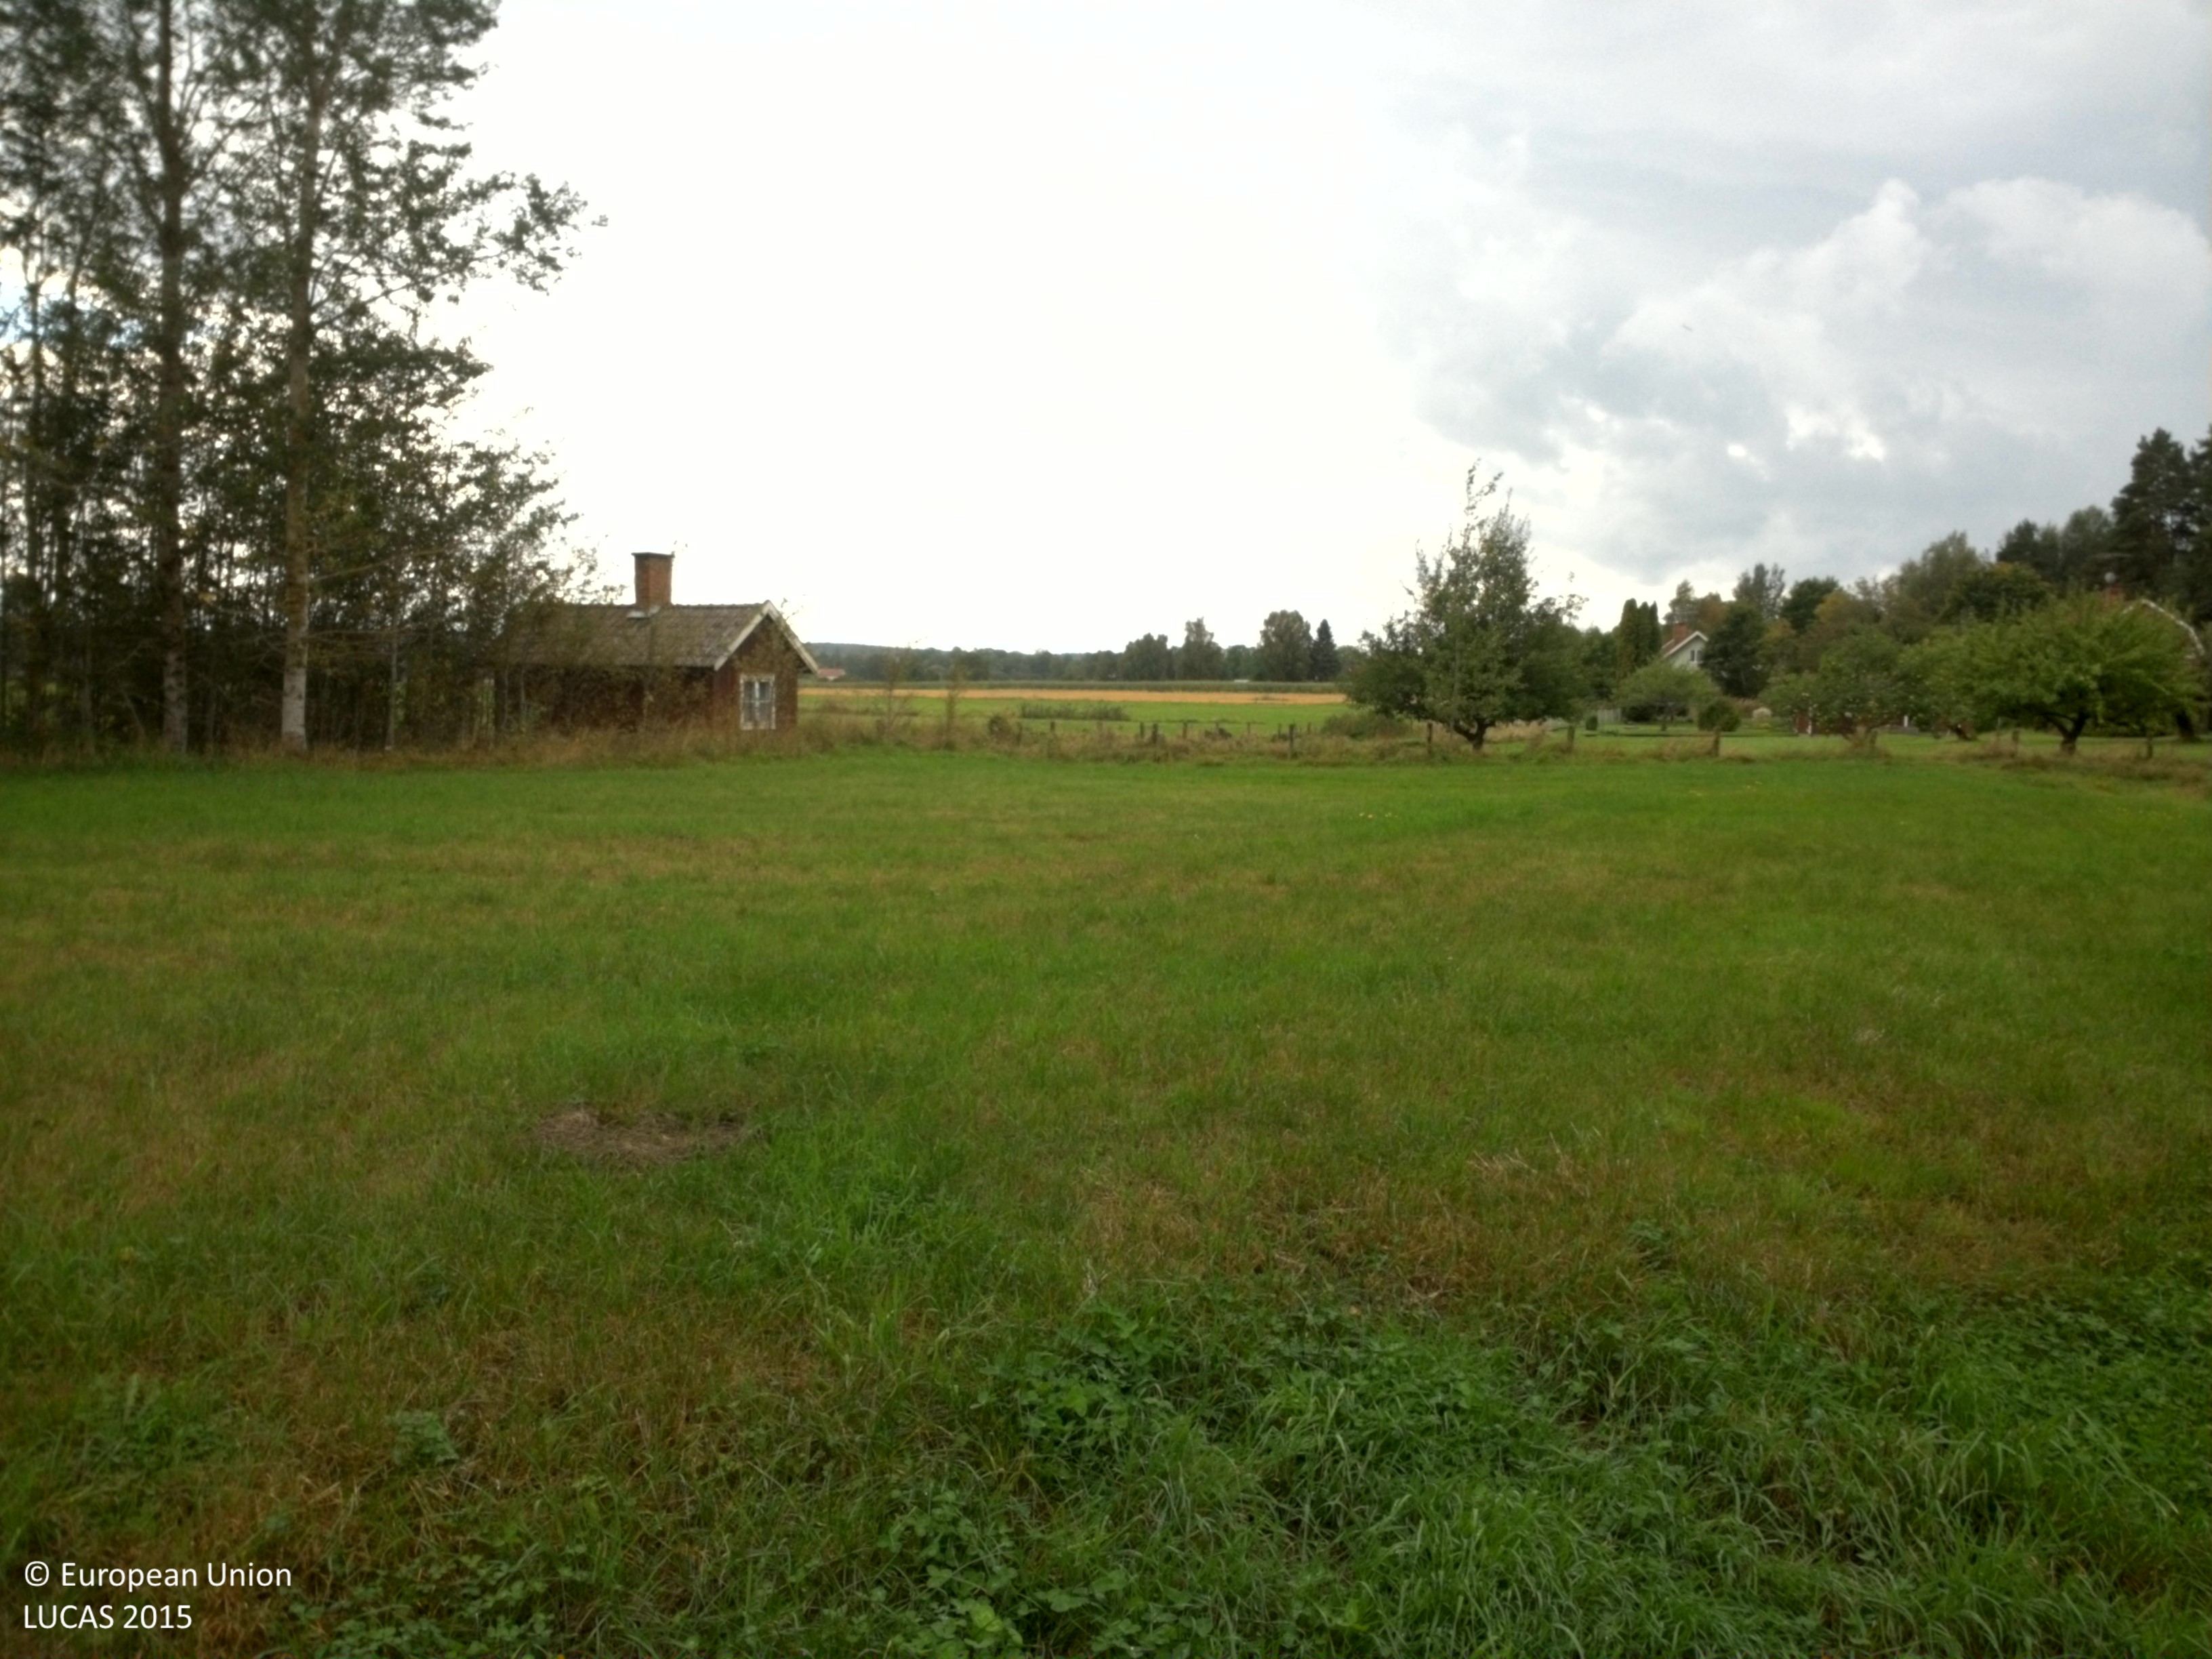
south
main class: Cropland
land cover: Temporary grasslands
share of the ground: > 75 %
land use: Agriculture (excluding fallow land and kitchen gardens)
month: September
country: SE
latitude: 59.0042
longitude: 14.0837
